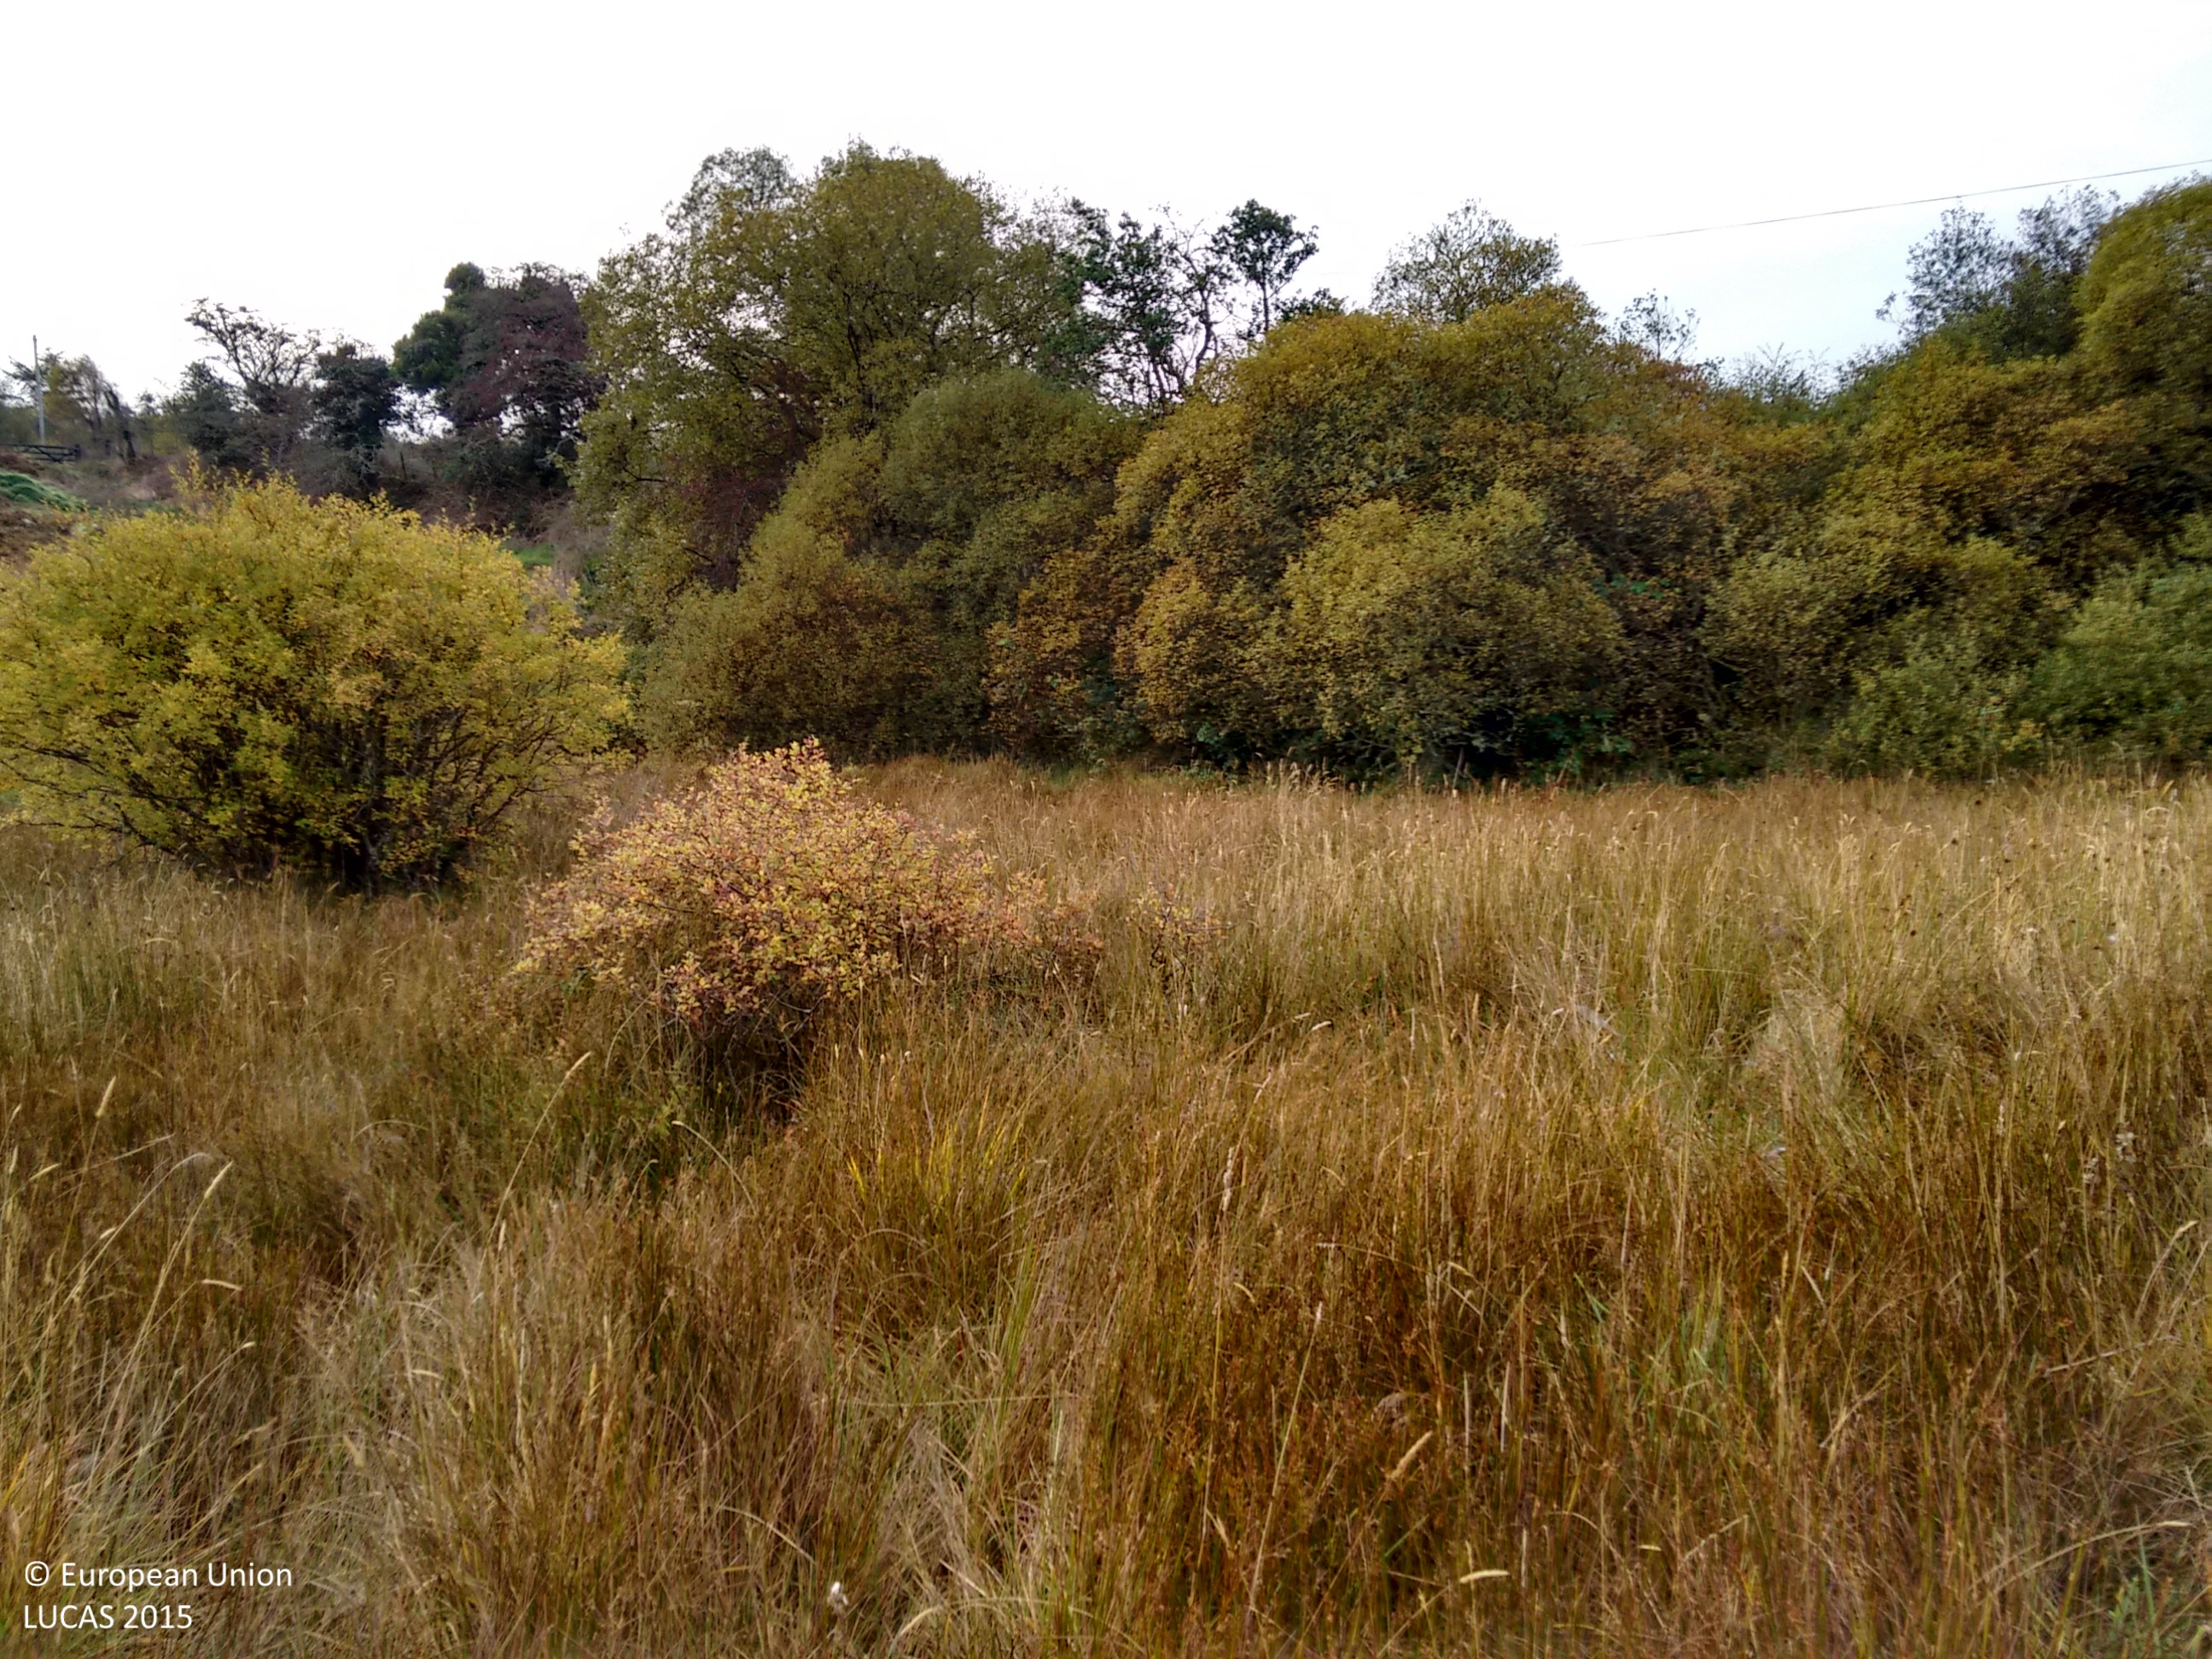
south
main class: Grassland
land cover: Grassland without tree/shrub cover
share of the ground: > 75 %
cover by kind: herbaceous plants 100 %
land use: Agriculture (excluding fallow land and kitchen gardens)
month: October
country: GB
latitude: 54.5301
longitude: -7.9895
